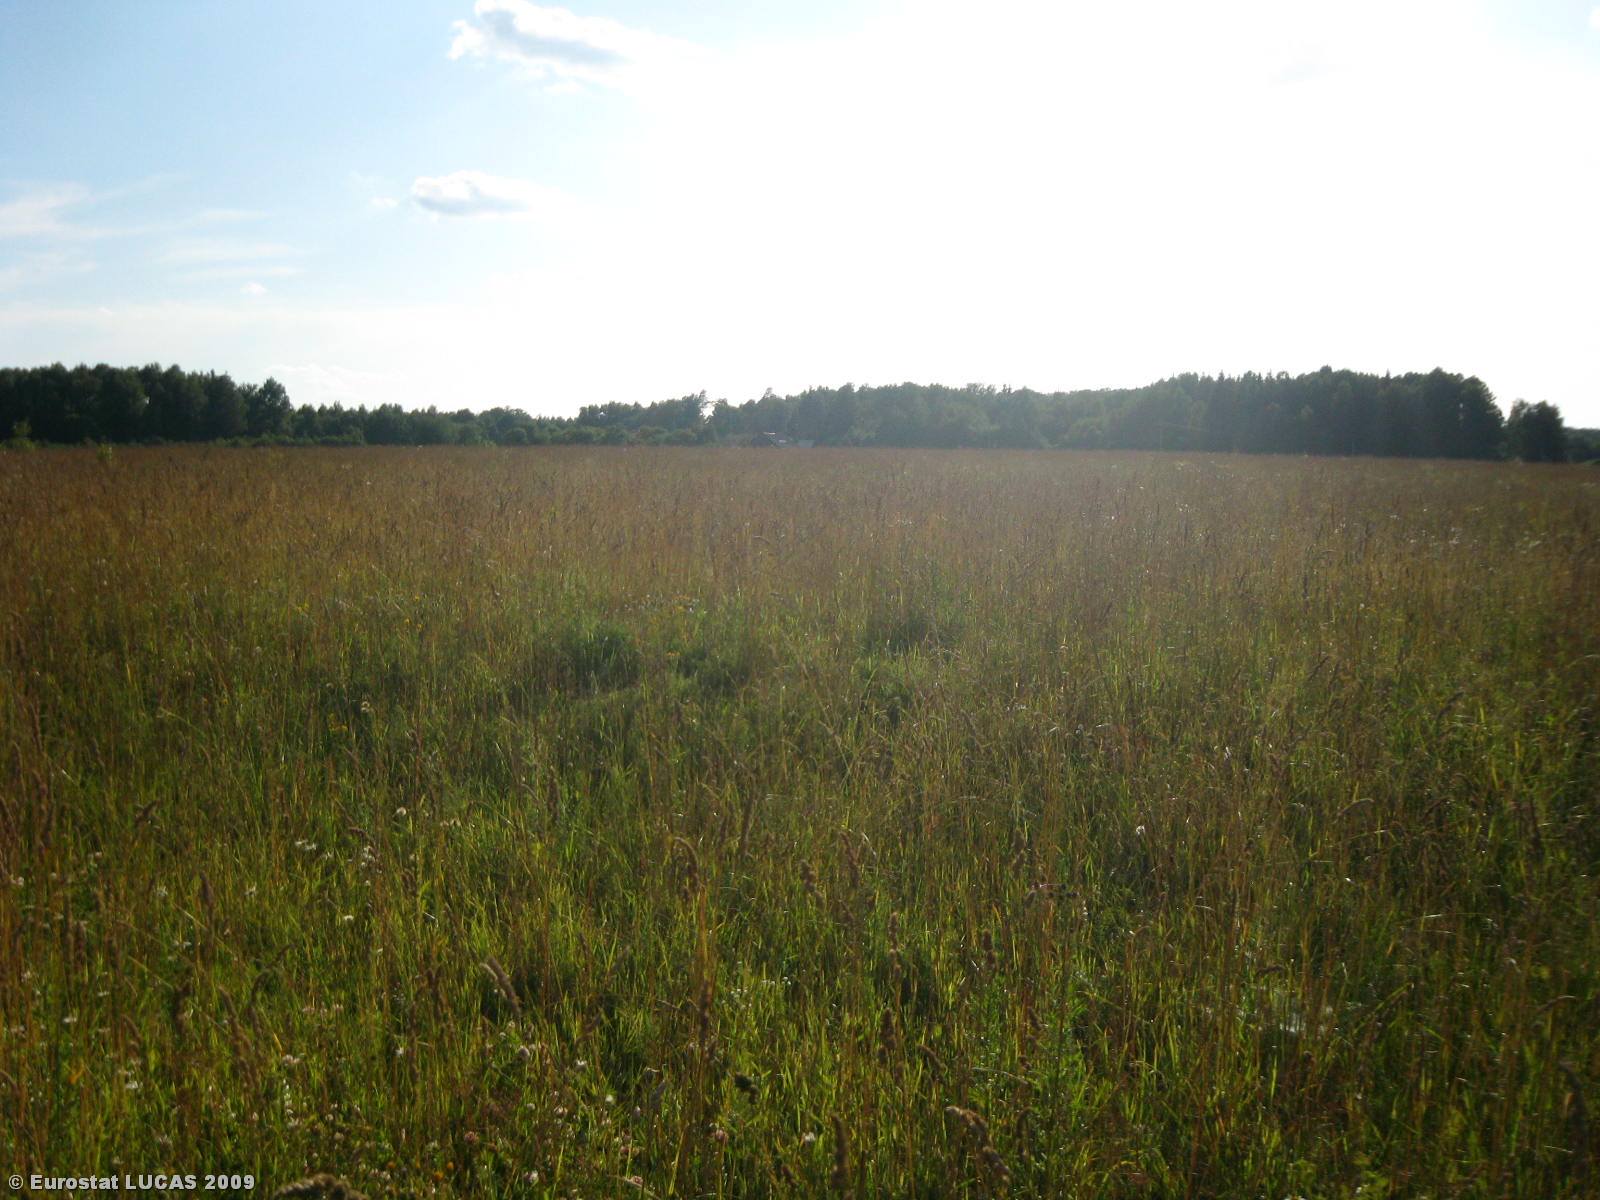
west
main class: Grassland
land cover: Grassland without tree/shrub cover
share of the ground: > 75 %
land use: Fallow land
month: July
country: LT
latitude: 55.0517
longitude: 24.6146
